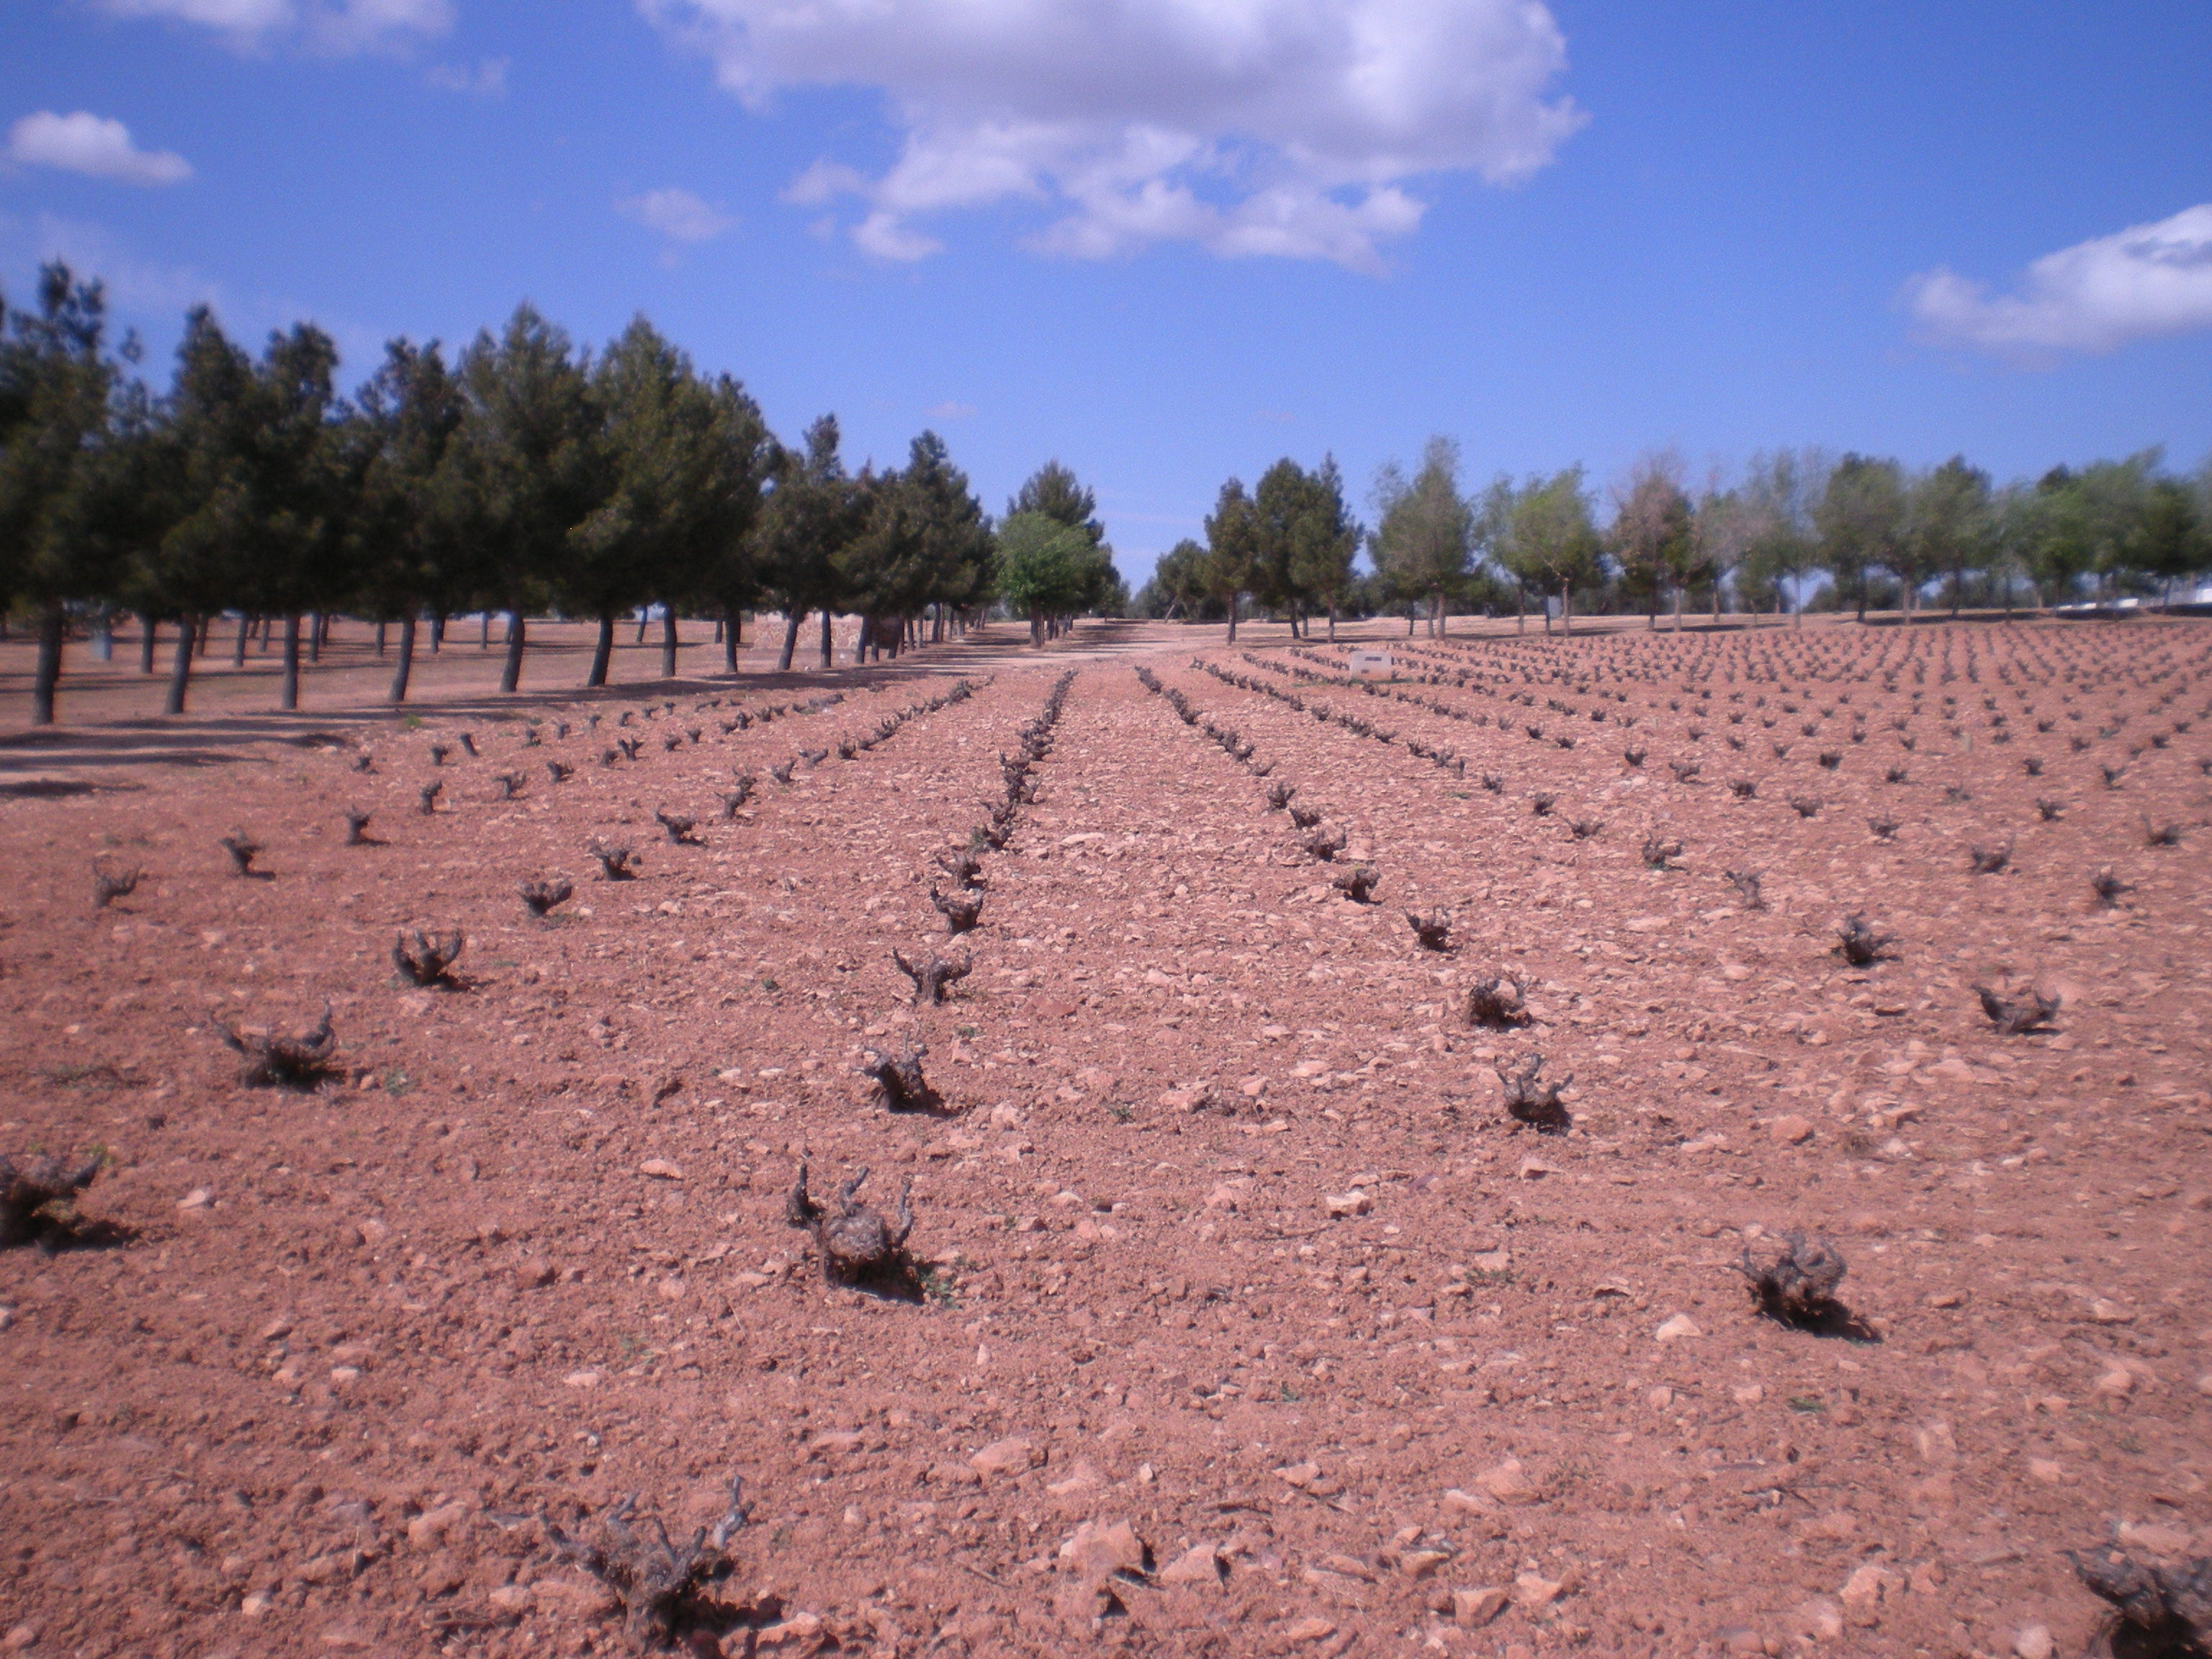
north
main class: Cropland
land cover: Vineyards
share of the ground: < 10 %
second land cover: Other bare soil
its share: > 75 %
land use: Agriculture (excluding fallow land and kitchen gardens)
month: April
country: ES
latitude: 38.7891
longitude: -3.5637
